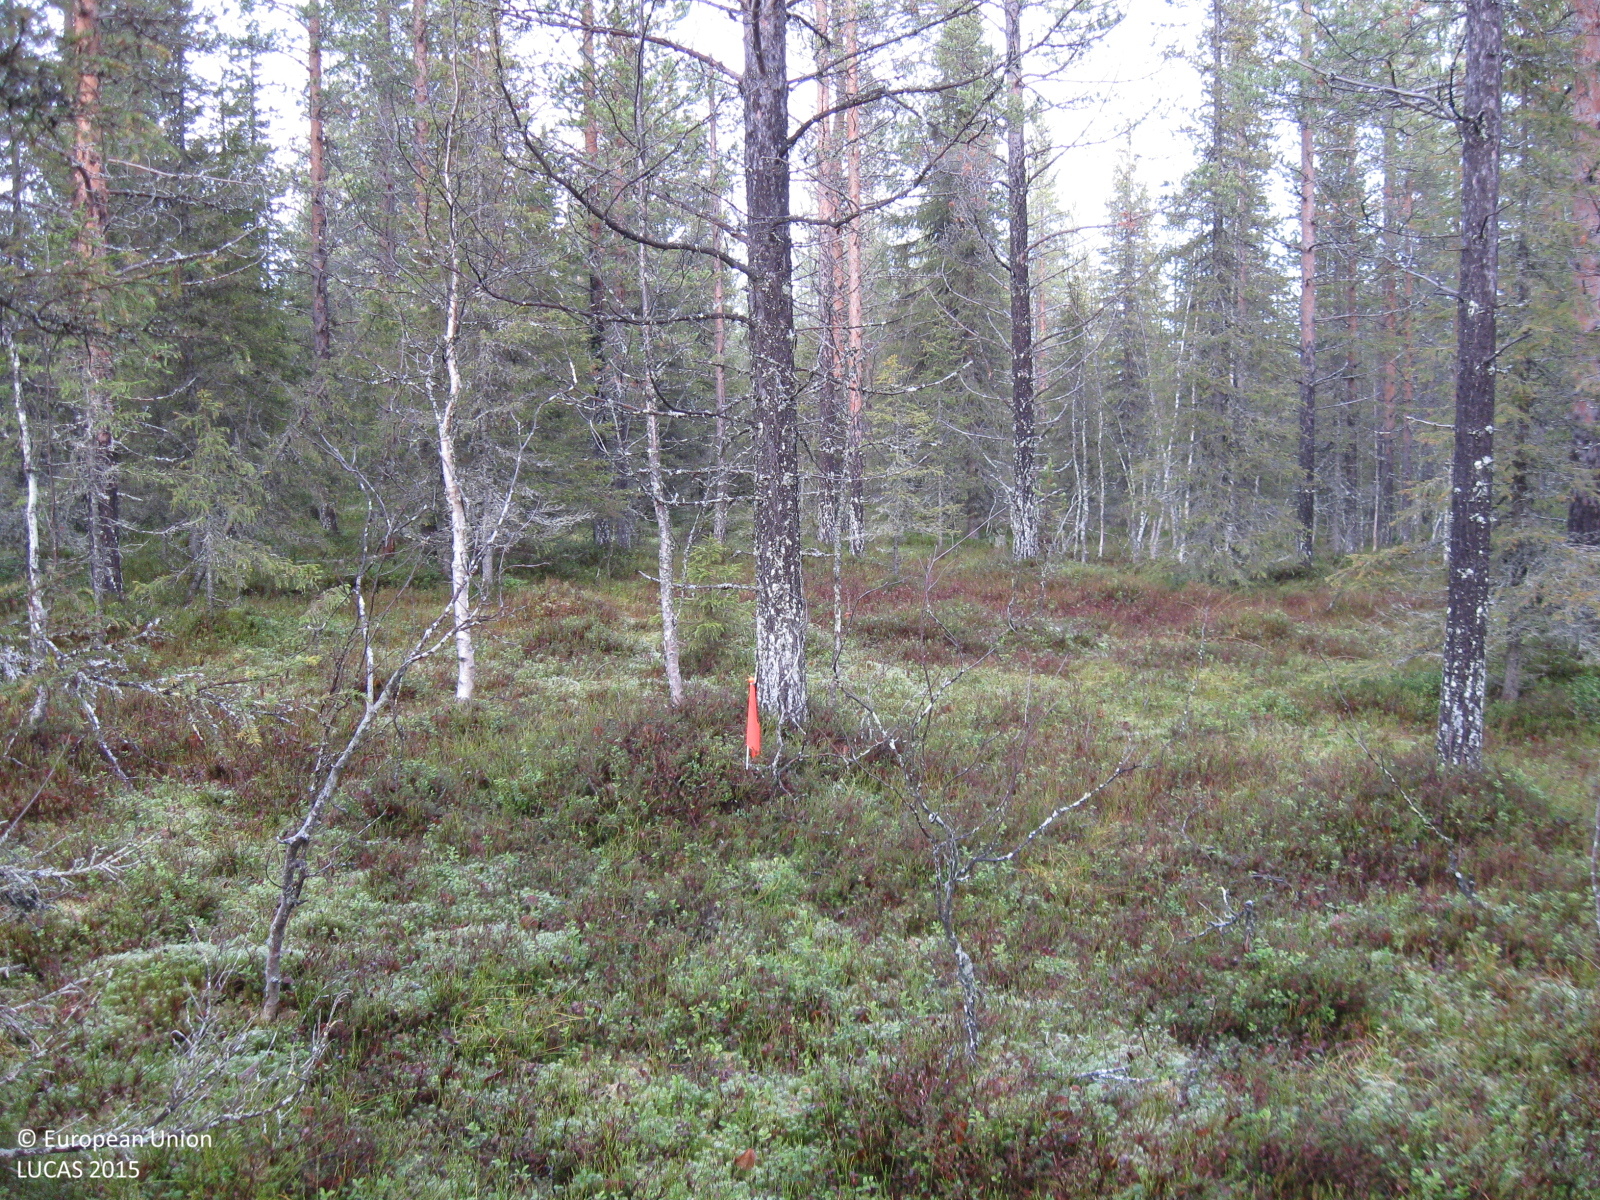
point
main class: Woodland
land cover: Pine dominated coniferous woodland
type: boreal forest
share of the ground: 50 - 75 %
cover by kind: coniferous forest trees 60 %, shrubs 15 %, broadleaved forest trees 10 %, lichens and mosses 10 %, herbaceous plants 5 %
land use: Forestry
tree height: > 5 m
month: October
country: SE
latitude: 66.5238
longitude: 21.5024
